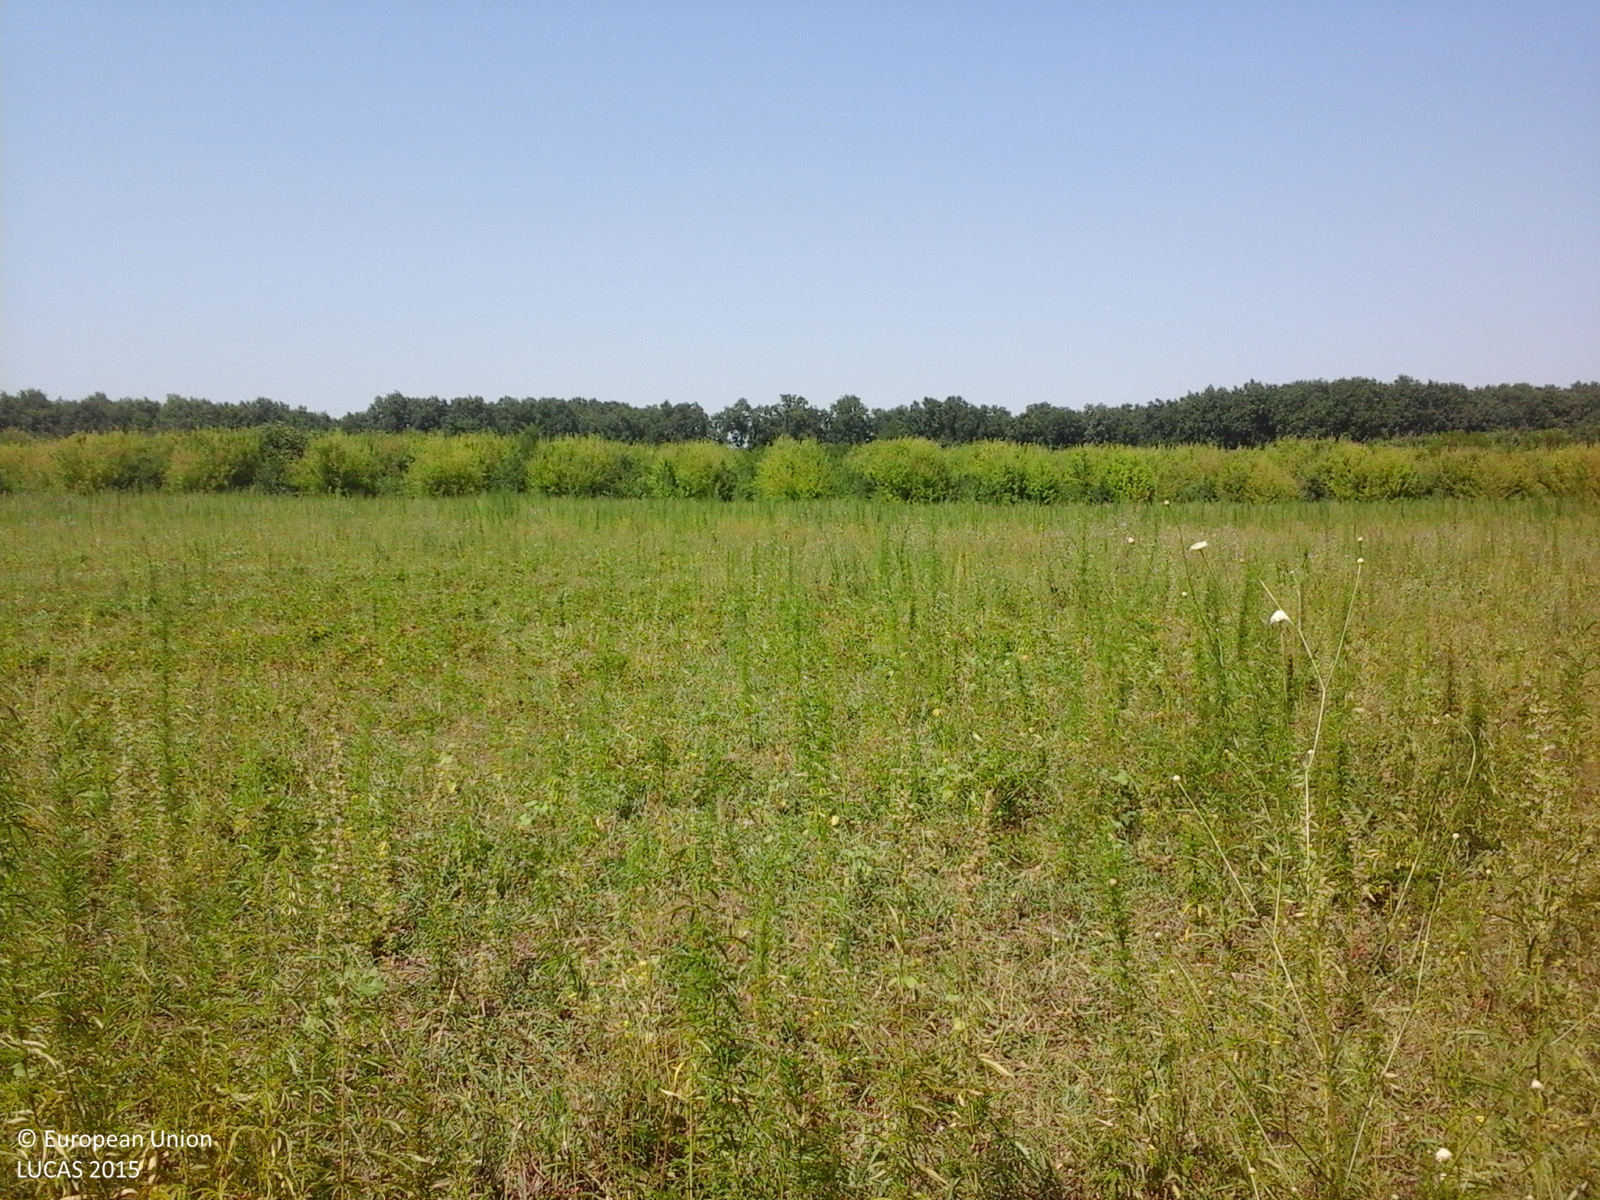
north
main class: Woodland
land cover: Broadleaved woodland
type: exotic forest
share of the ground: > 75 %
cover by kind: broadleaved forest trees 100 %
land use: Forestry
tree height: > 5 m
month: July
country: RO
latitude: 44.8653
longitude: 27.3422
